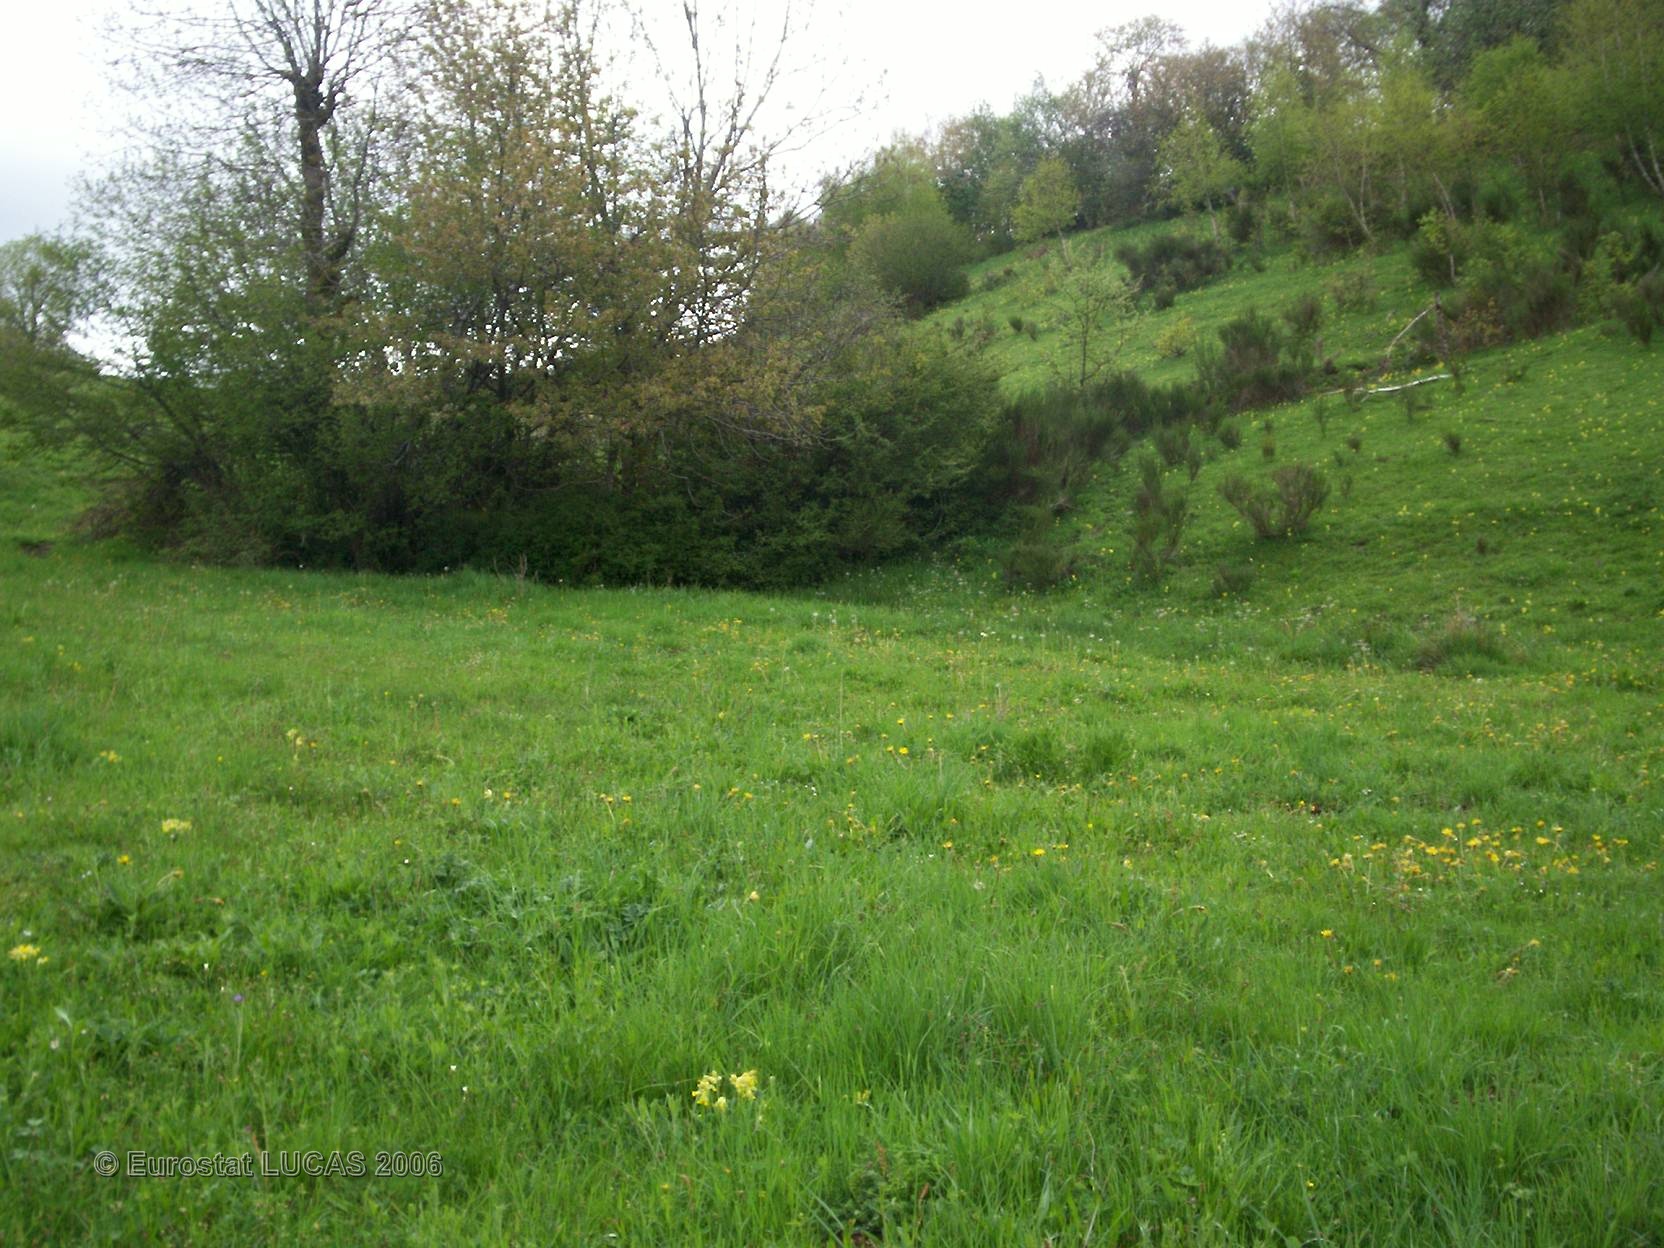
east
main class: Grassland
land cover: Grassland without tree/shrub cover
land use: Agriculture (excluding fallow land and kitchen gardens)
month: May
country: FR
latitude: 45.2154
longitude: 3.2405
